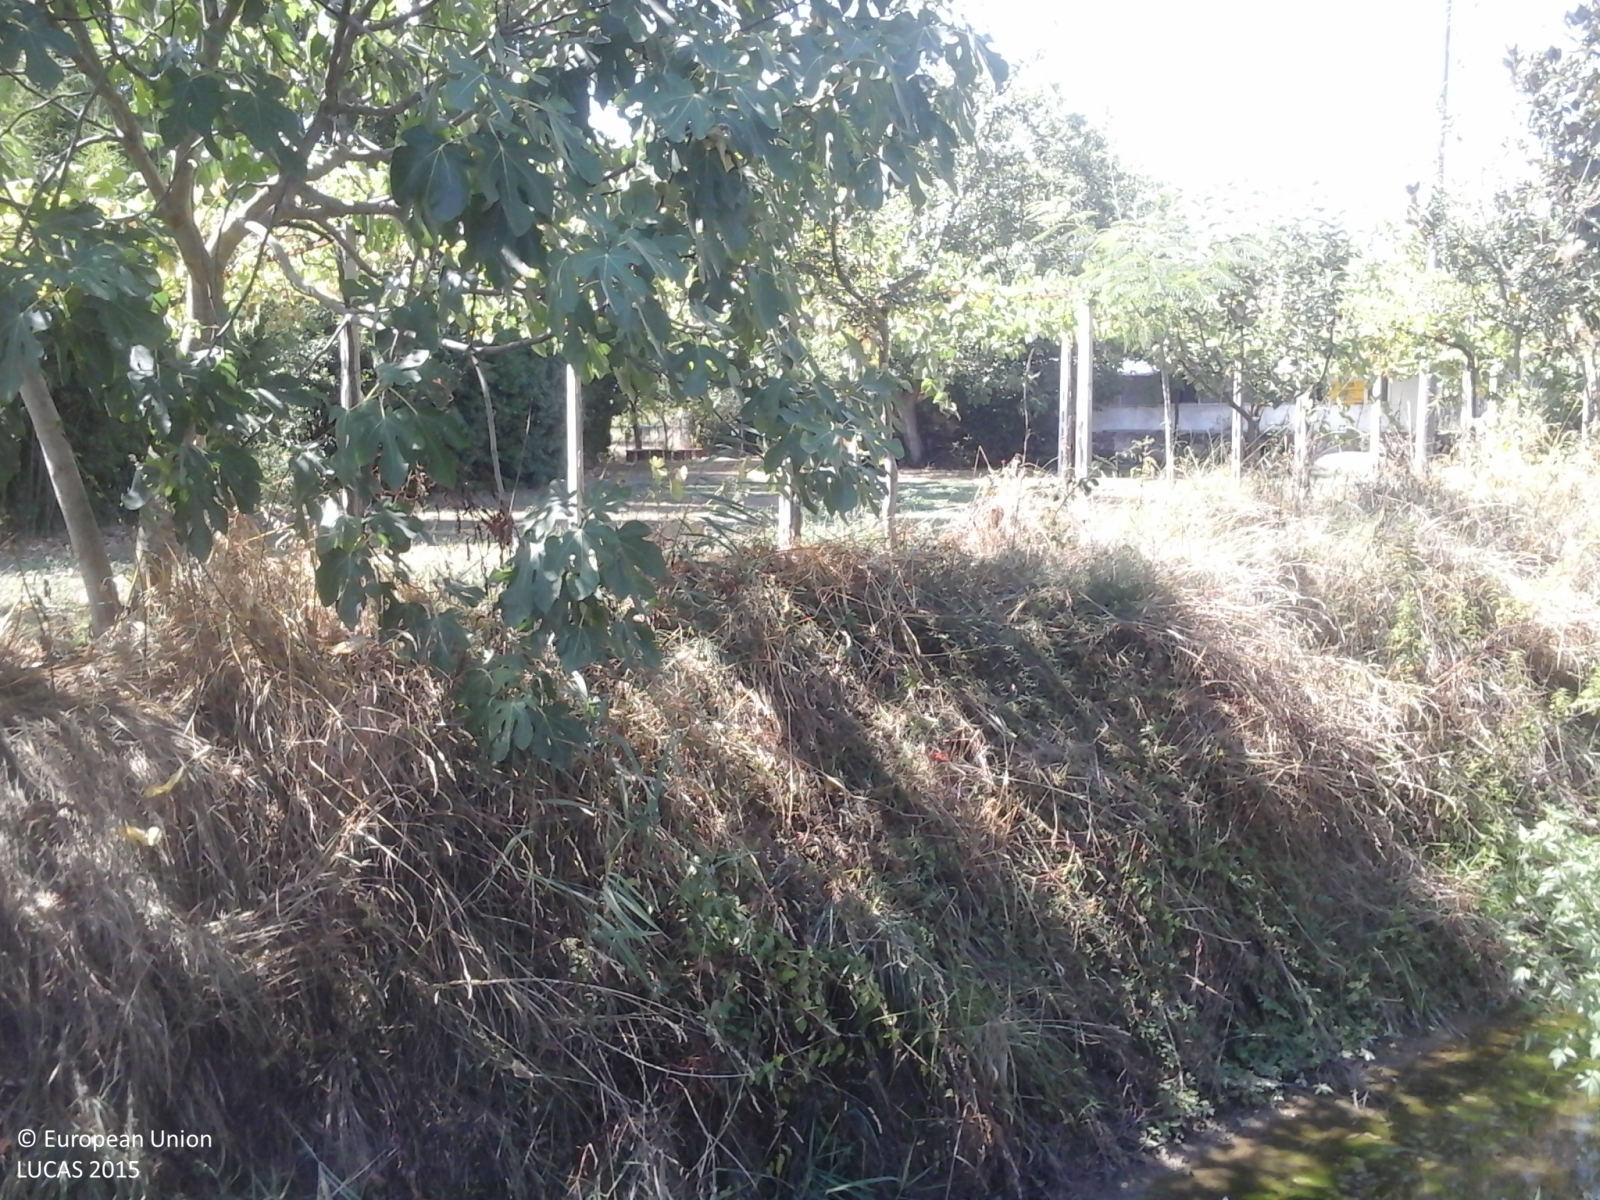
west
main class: Grassland
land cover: Grassland without tree/shrub cover
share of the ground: > 75 %
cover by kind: herbaceous plants 100 %
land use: Residential
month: August
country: IT
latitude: 43.8605
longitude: 10.7818
